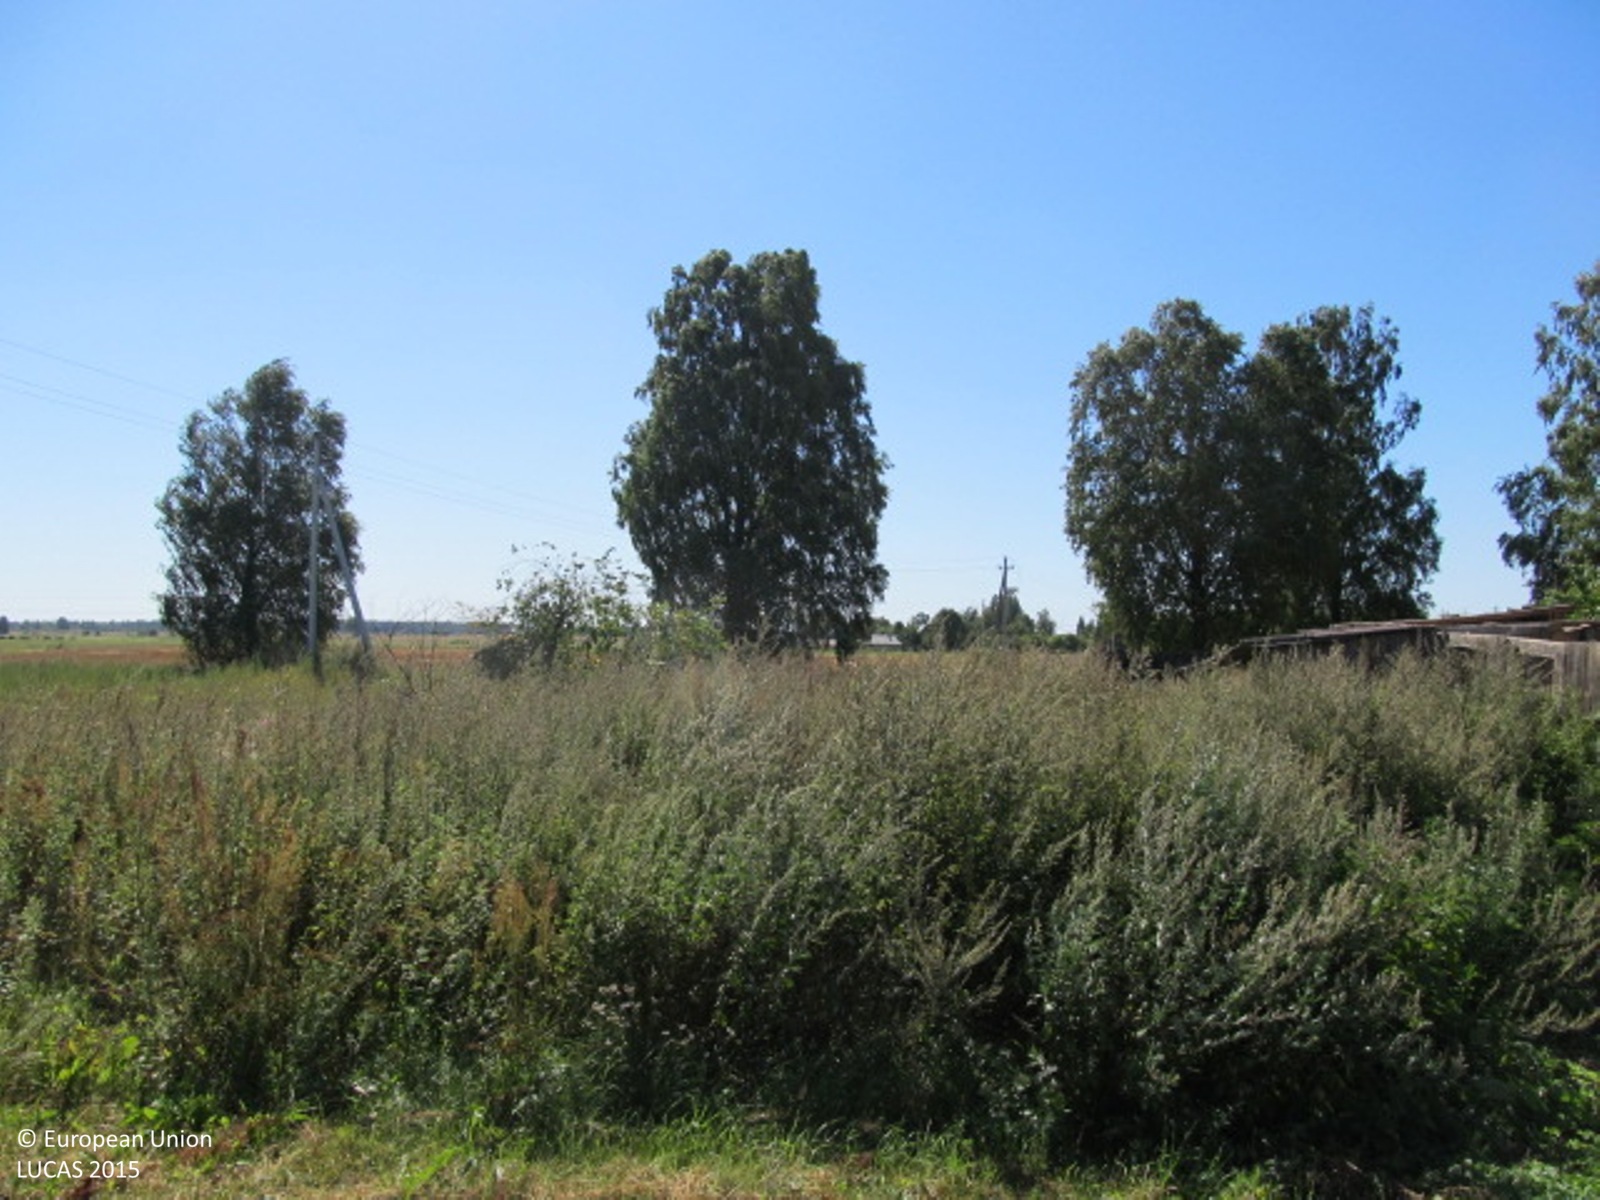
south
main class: Grassland
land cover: Grassland without tree/shrub cover
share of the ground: > 75 %
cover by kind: herbaceous plants 100 %
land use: Agriculture (excluding fallow land and kitchen gardens)
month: August
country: LT
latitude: 56.1884
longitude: 22.5471
